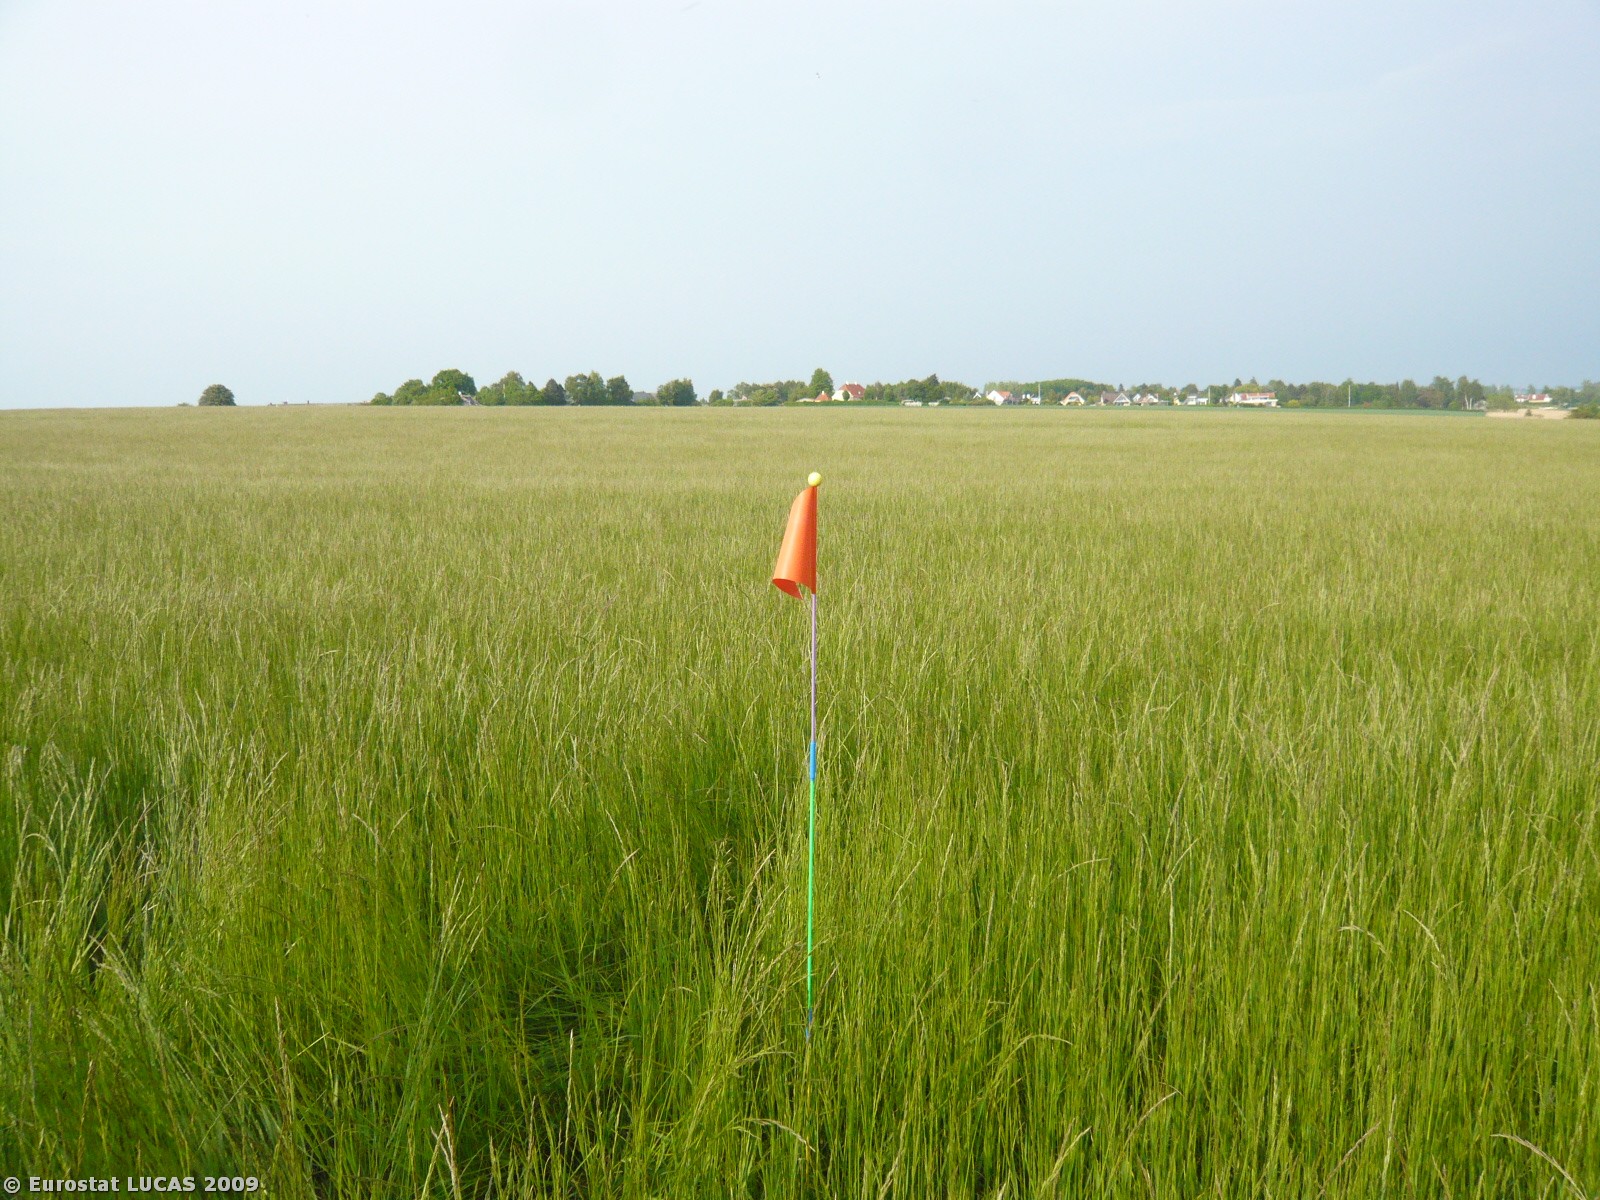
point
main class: Grassland
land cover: Grassland without tree/shrub cover
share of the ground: > 75 %
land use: Agriculture (excluding fallow land and kitchen gardens)
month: May
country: DK
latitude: 55.2059
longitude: 11.6801
